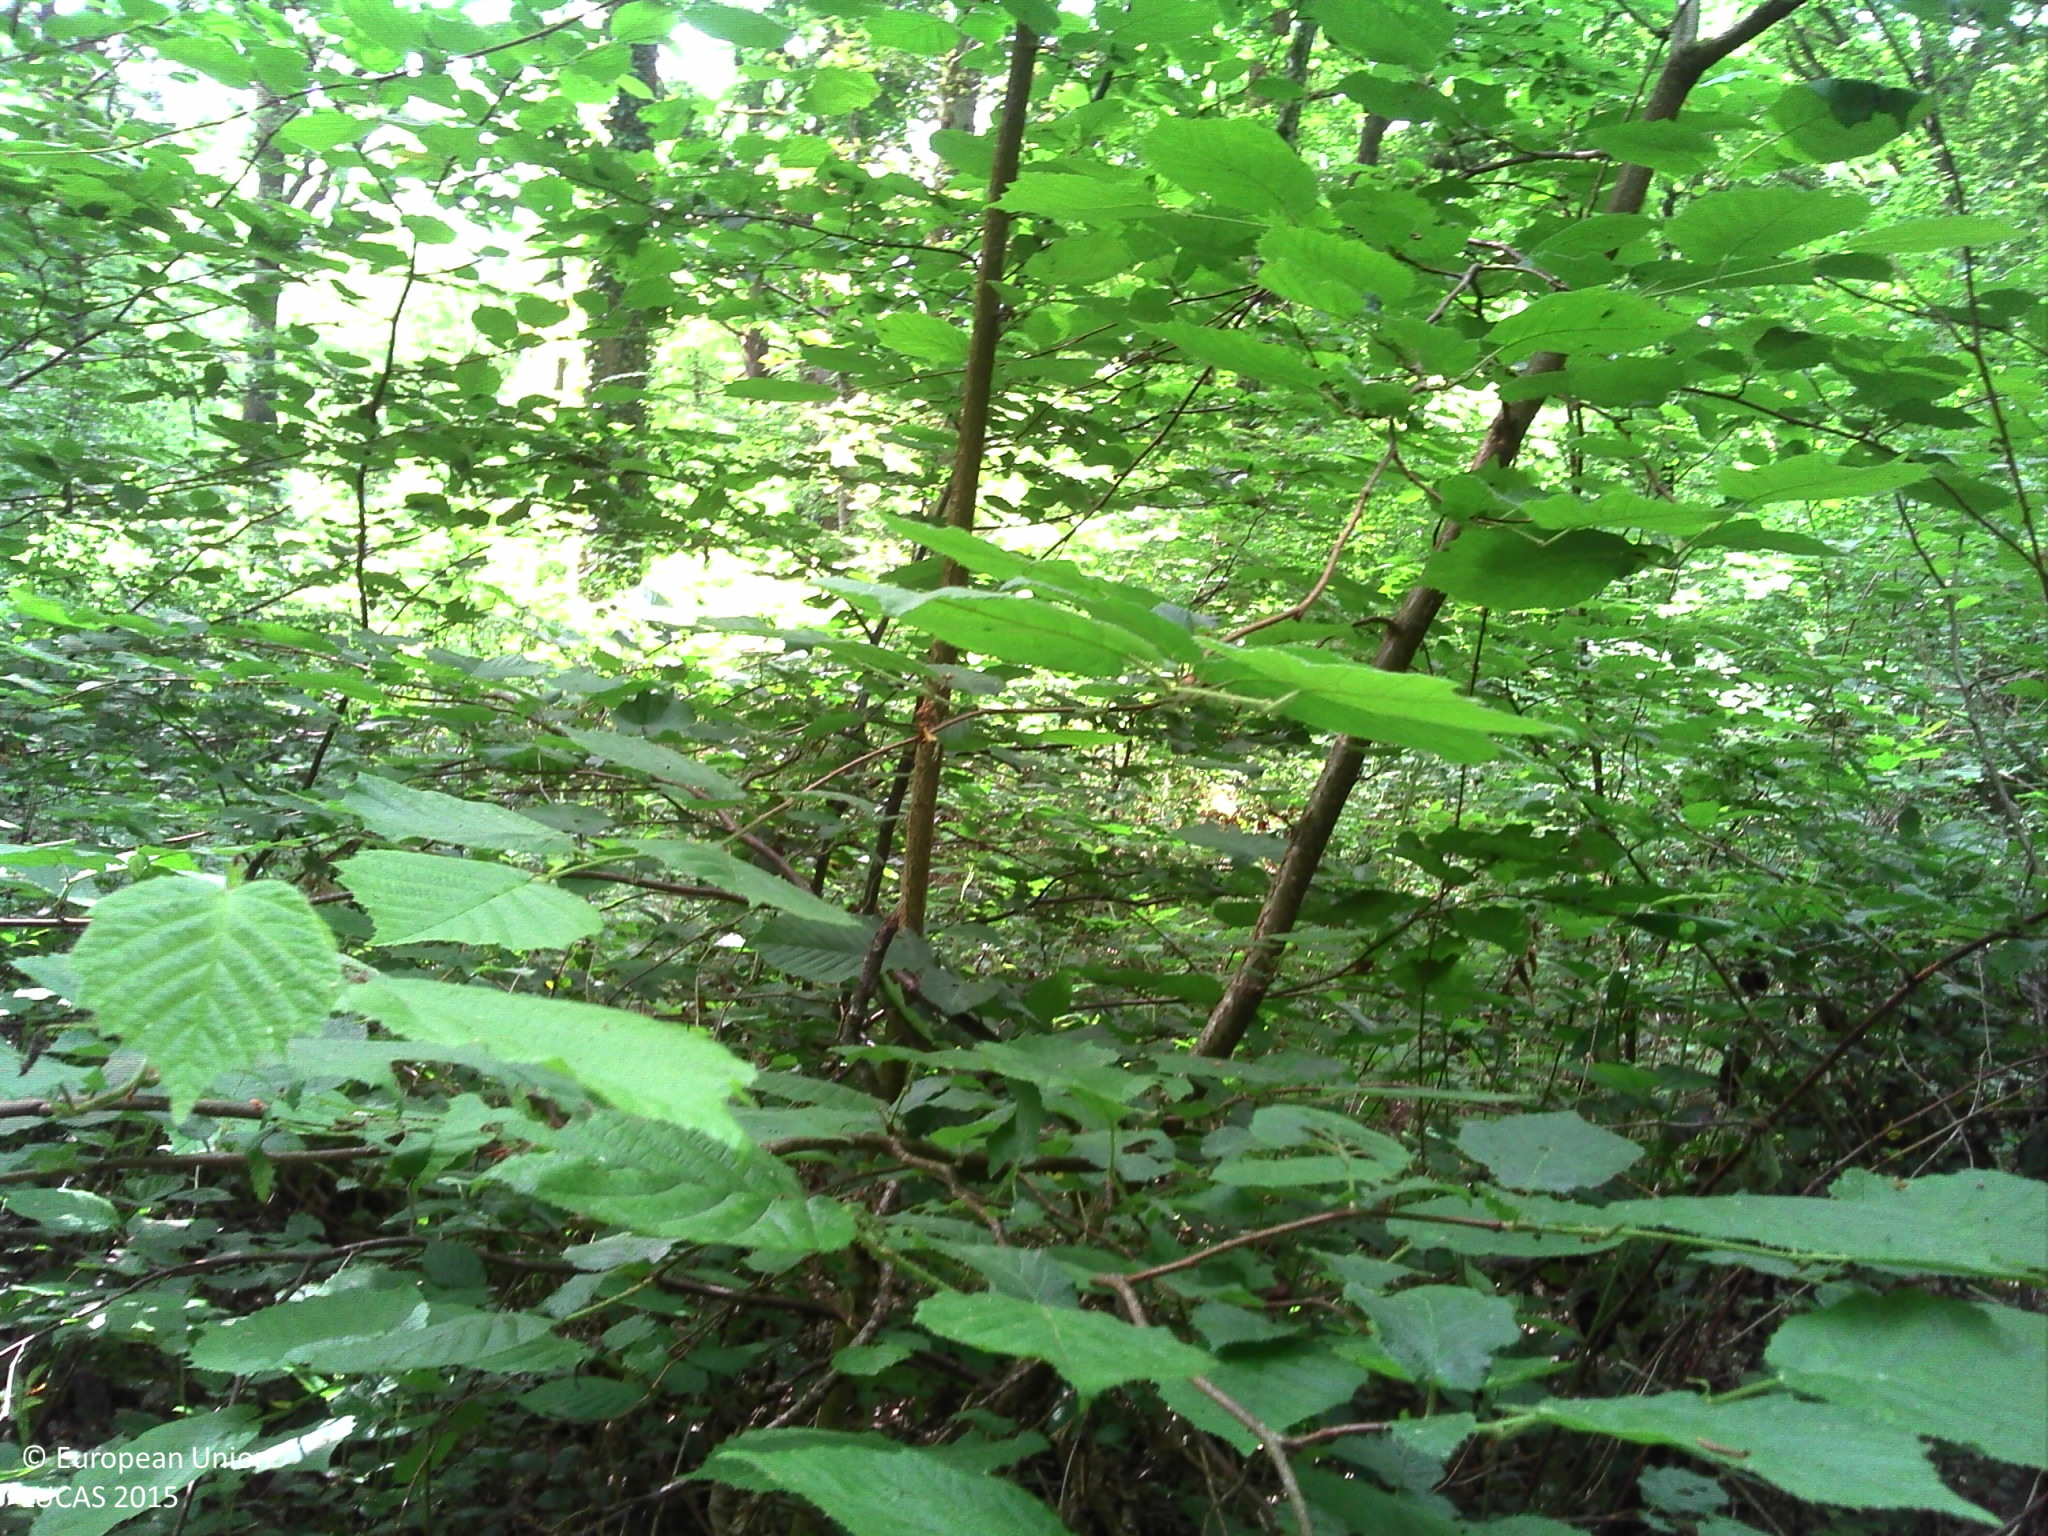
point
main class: Woodland
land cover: Broadleaved woodland
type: mesophytic deciduous forest
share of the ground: > 75 %
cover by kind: broadleaved forest trees 90 %, herbaceous plants 10 %
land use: Forestry
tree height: > 5 m
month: May
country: FR
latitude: 47.2393
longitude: 5.2850
